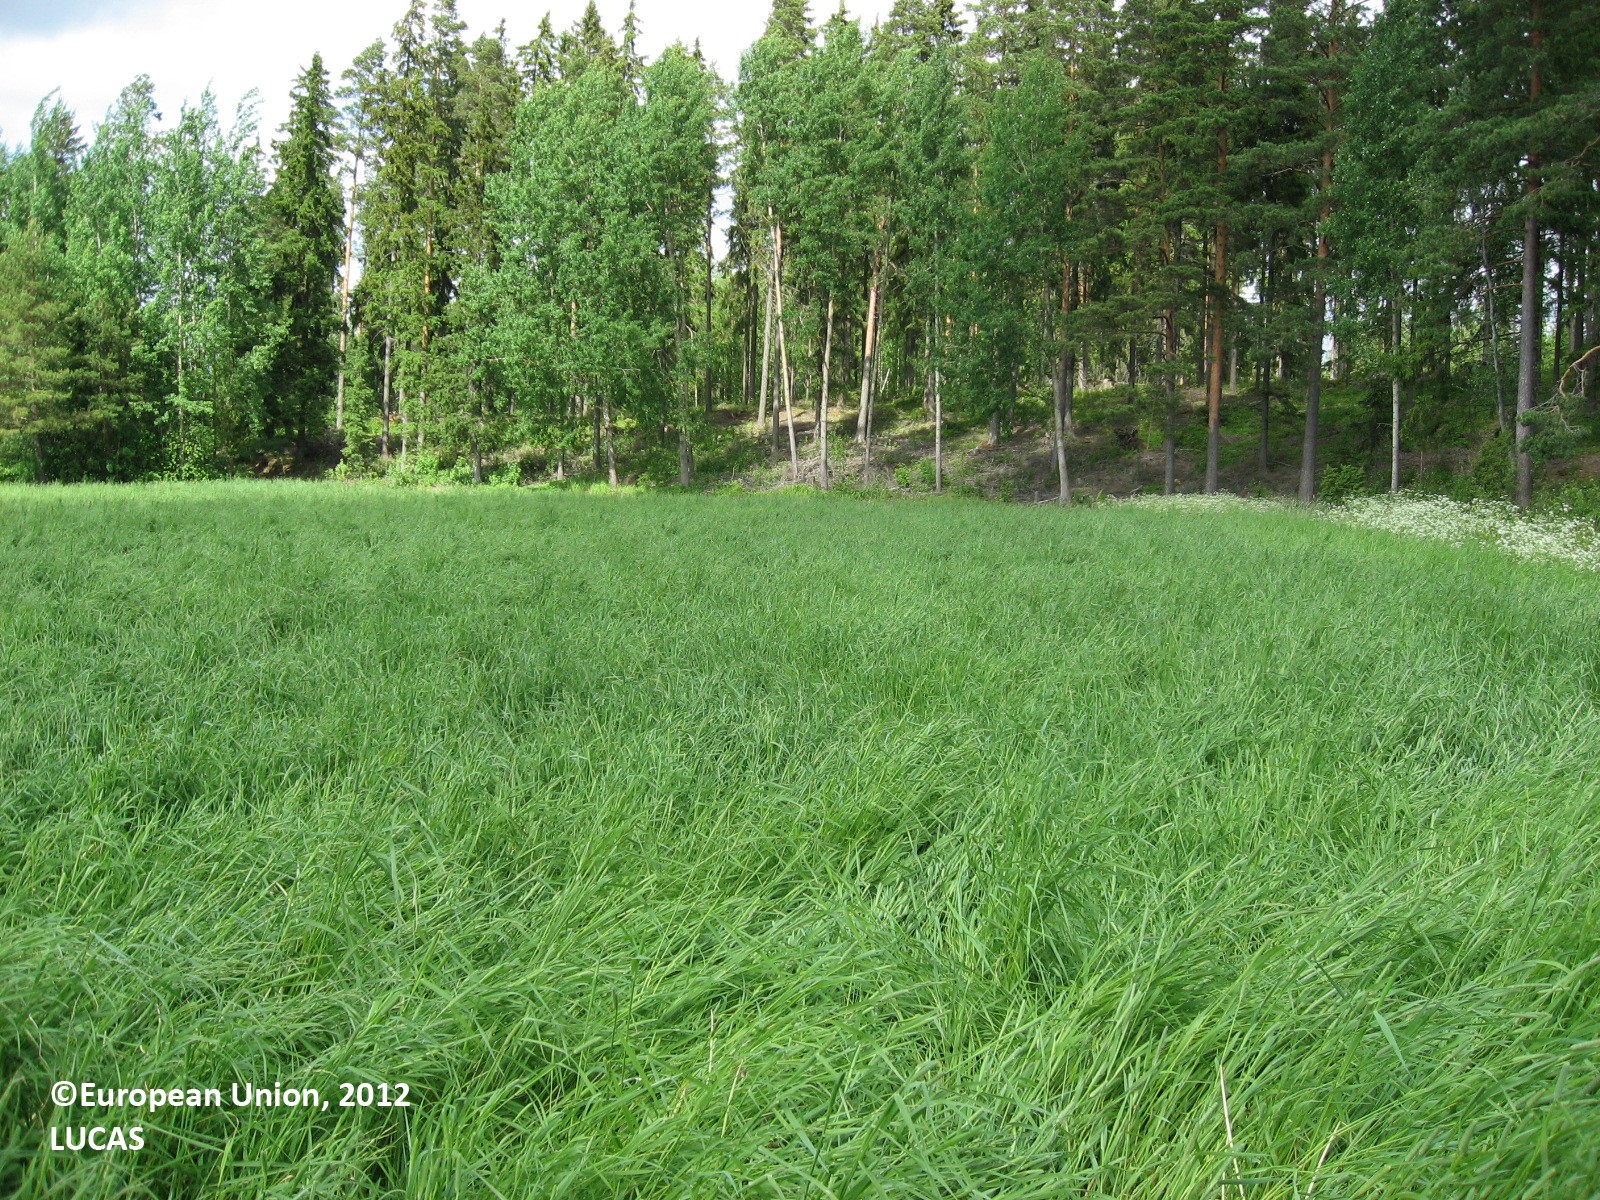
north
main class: Cropland
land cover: Temporary grasslands
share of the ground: > 75 %
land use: Agriculture (excluding fallow land and kitchen gardens)
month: June
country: FI
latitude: 60.6187
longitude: 26.5091
